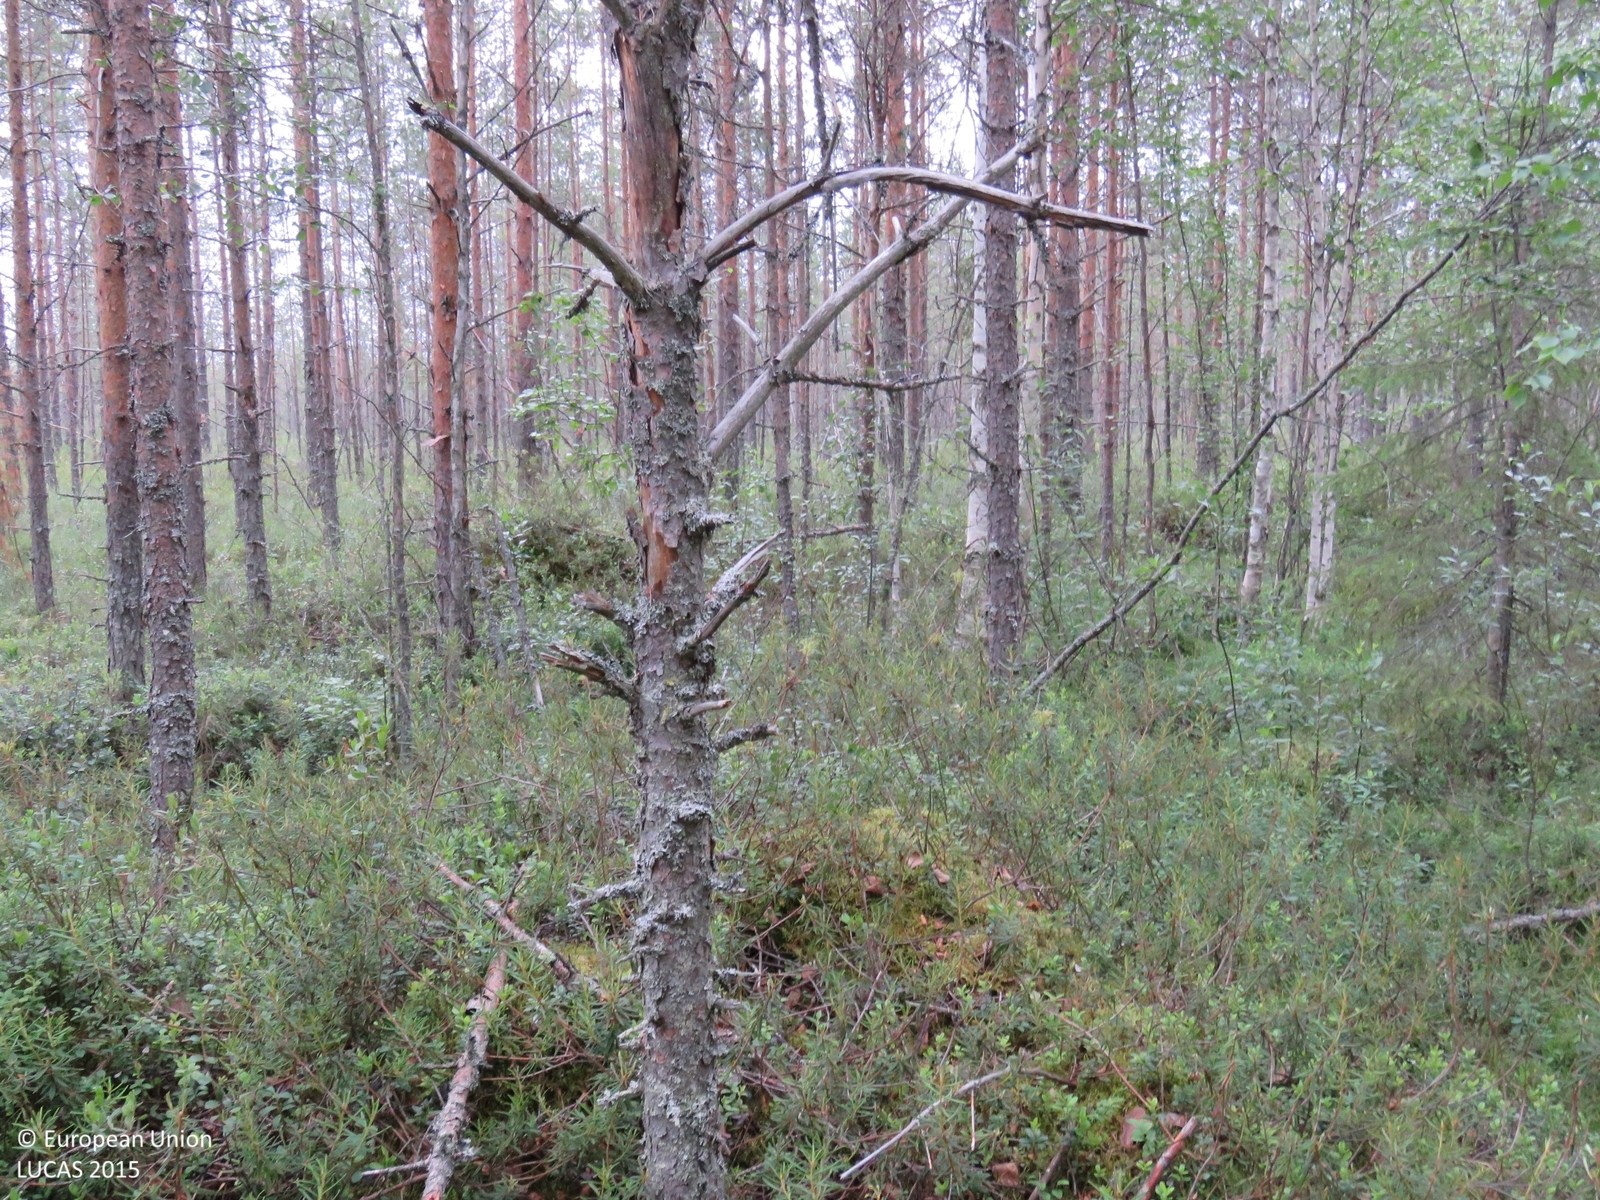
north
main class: Woodland
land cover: Pine dominated coniferous woodland
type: mire and swamp forests
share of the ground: > 75 %
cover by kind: coniferous forest trees 70 %, broadleaved forest trees 20 %, shrubs 10 %
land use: Forestry
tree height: > 5 m
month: July
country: FI
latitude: 64.2814
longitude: 26.5380
